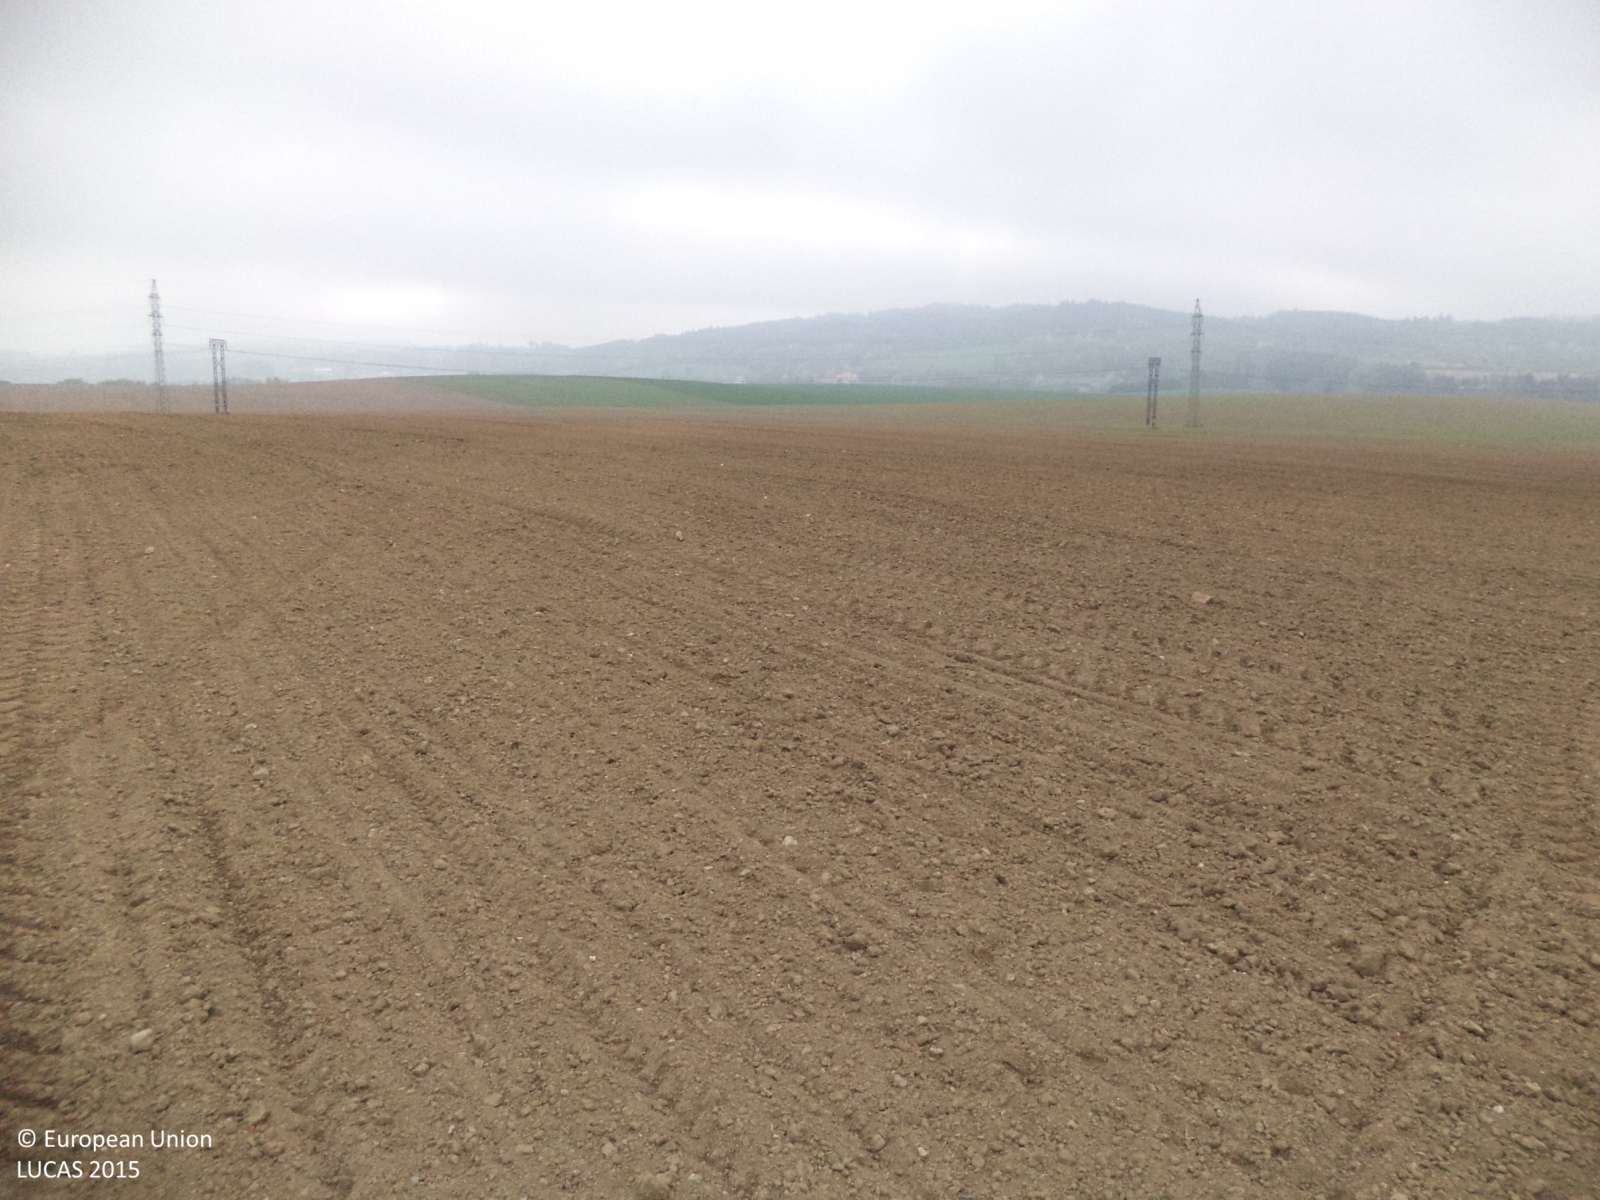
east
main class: Cropland
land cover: Maize
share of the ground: < 10 %
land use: Agriculture (excluding fallow land and kitchen gardens)
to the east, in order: Maize
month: May
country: CZ
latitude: 49.1873
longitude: 15.4779
